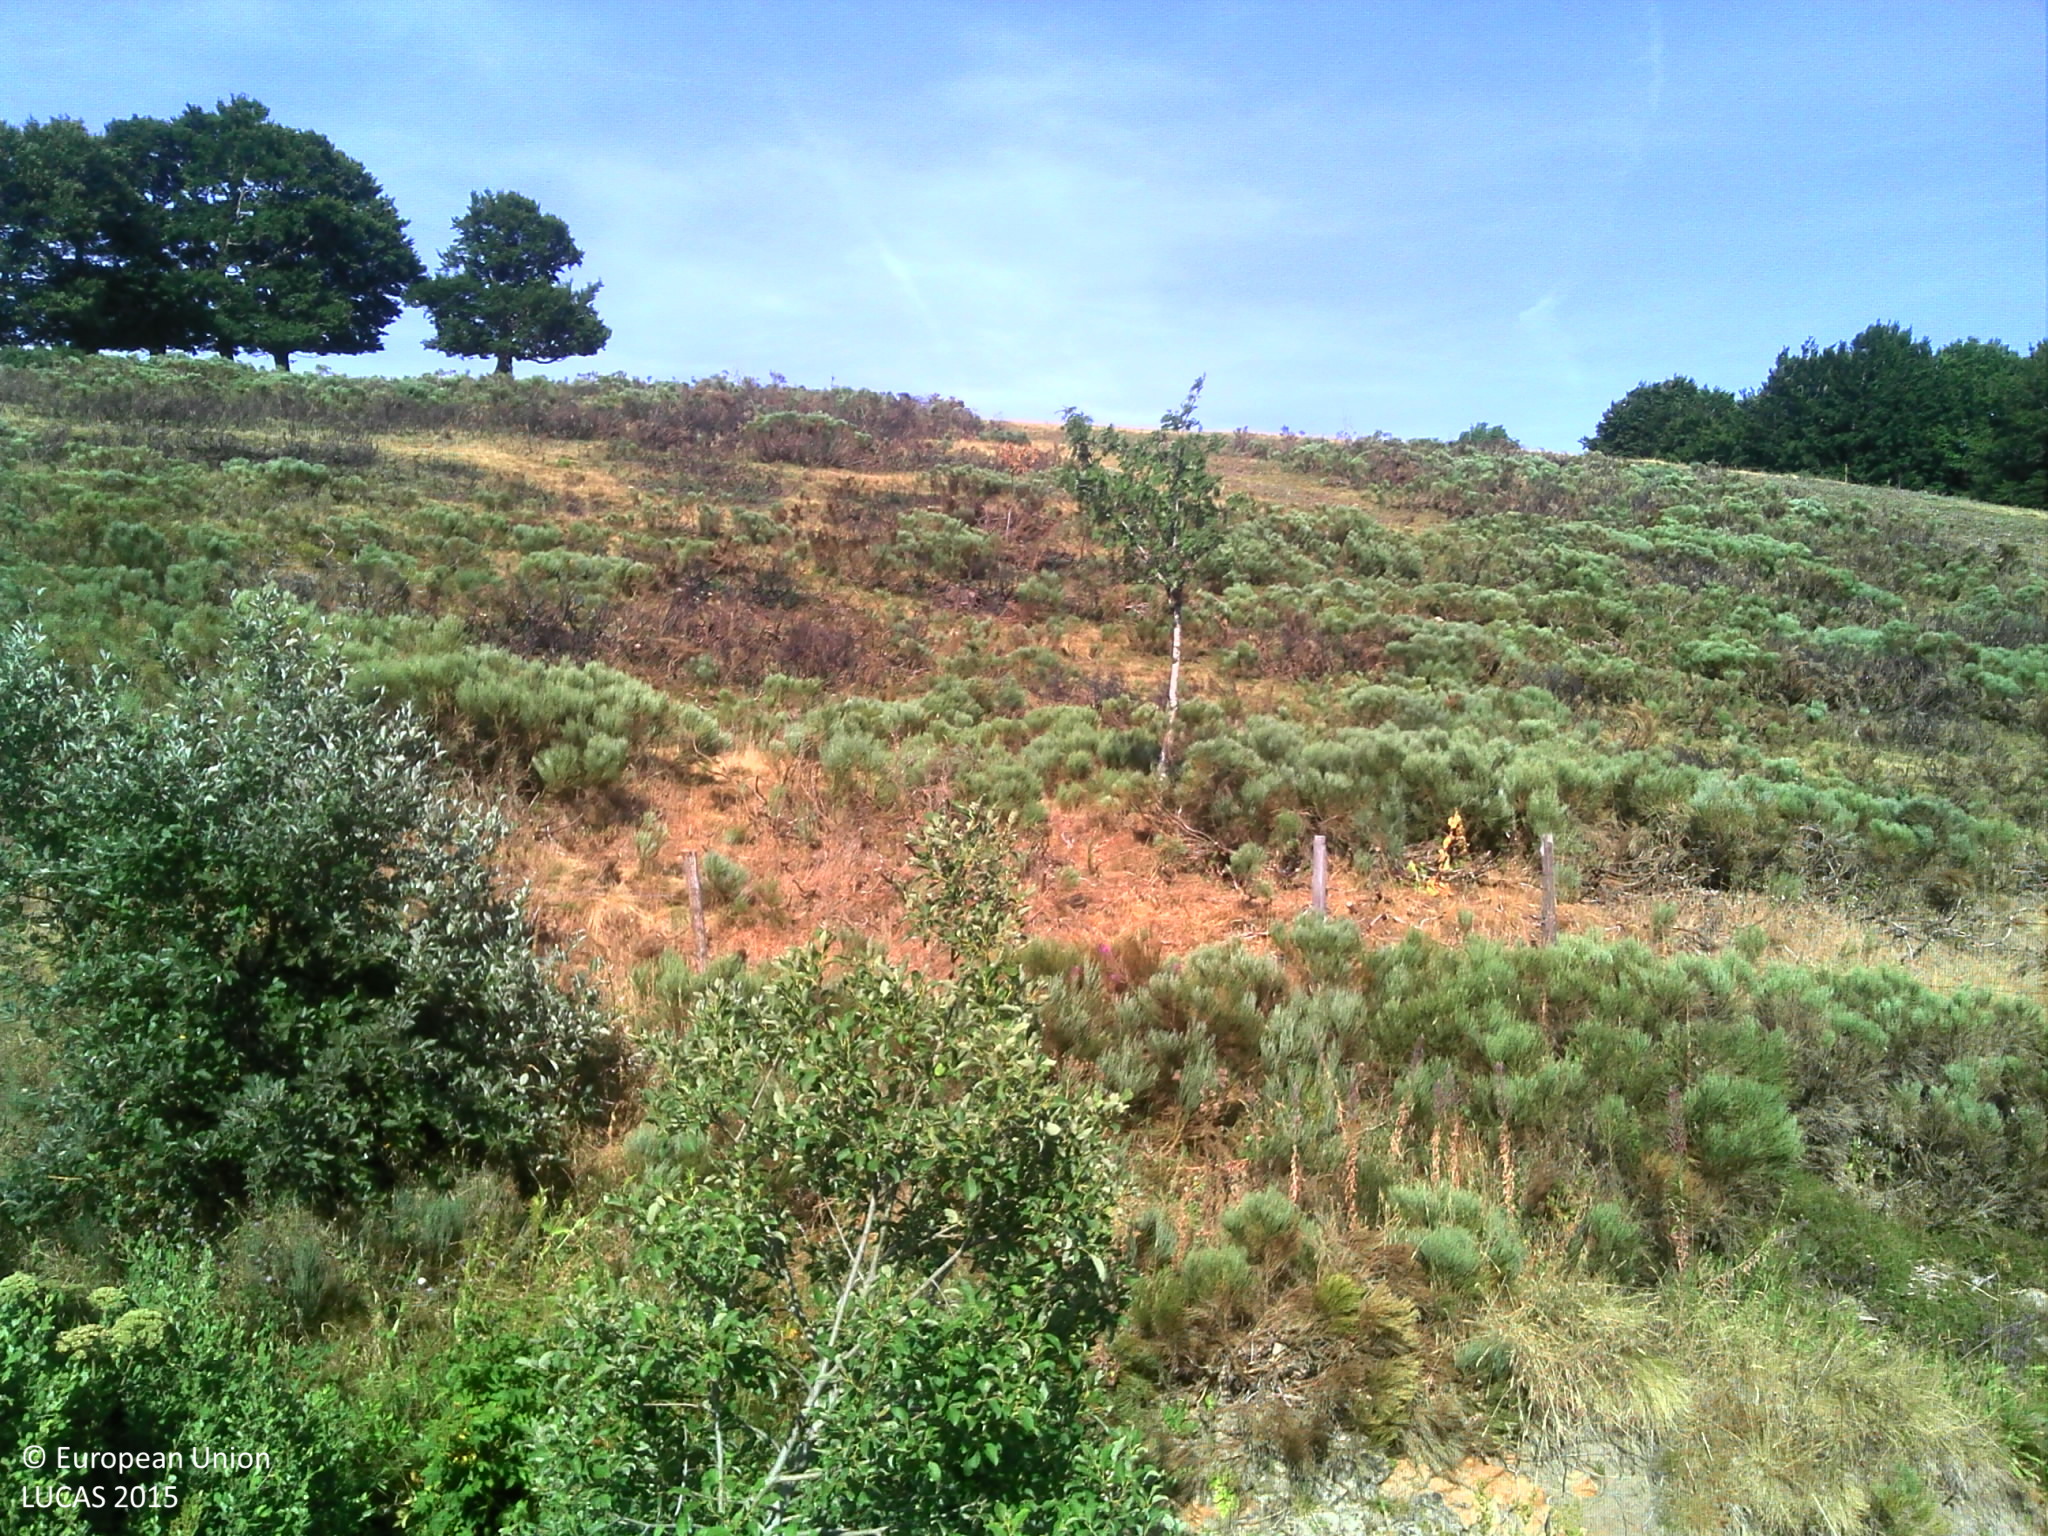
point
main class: Shrubland
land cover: Shrubland without tree cover
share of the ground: > 75 %
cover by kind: shrubs 70 %, herbaceous plants 30 %
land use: Agriculture (excluding fallow land and kitchen gardens)
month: August
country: FR
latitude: 44.8390
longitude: 4.1987
